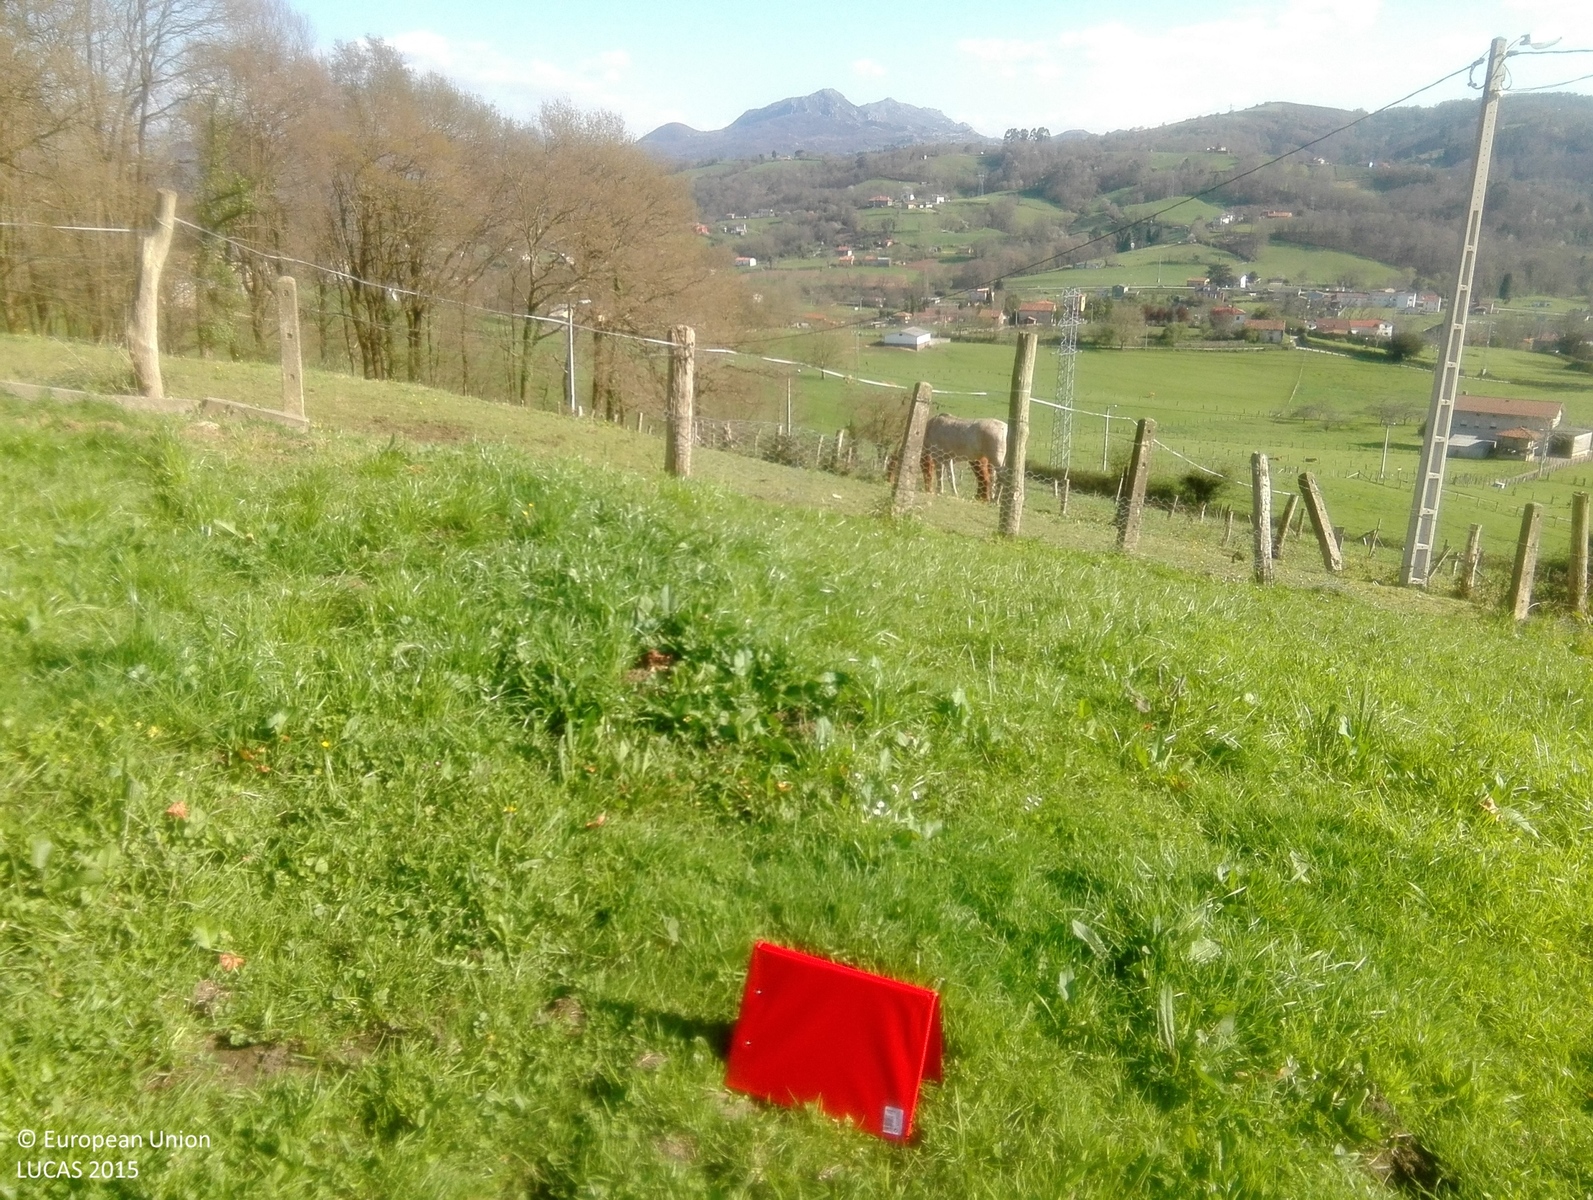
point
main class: Grassland
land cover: Grassland without tree/shrub cover
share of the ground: > 75 %
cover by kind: herbaceous plants 100 %
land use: Agriculture (excluding fallow land and kitchen gardens)
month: April
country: ES
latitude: 43.3862
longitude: -5.5740
